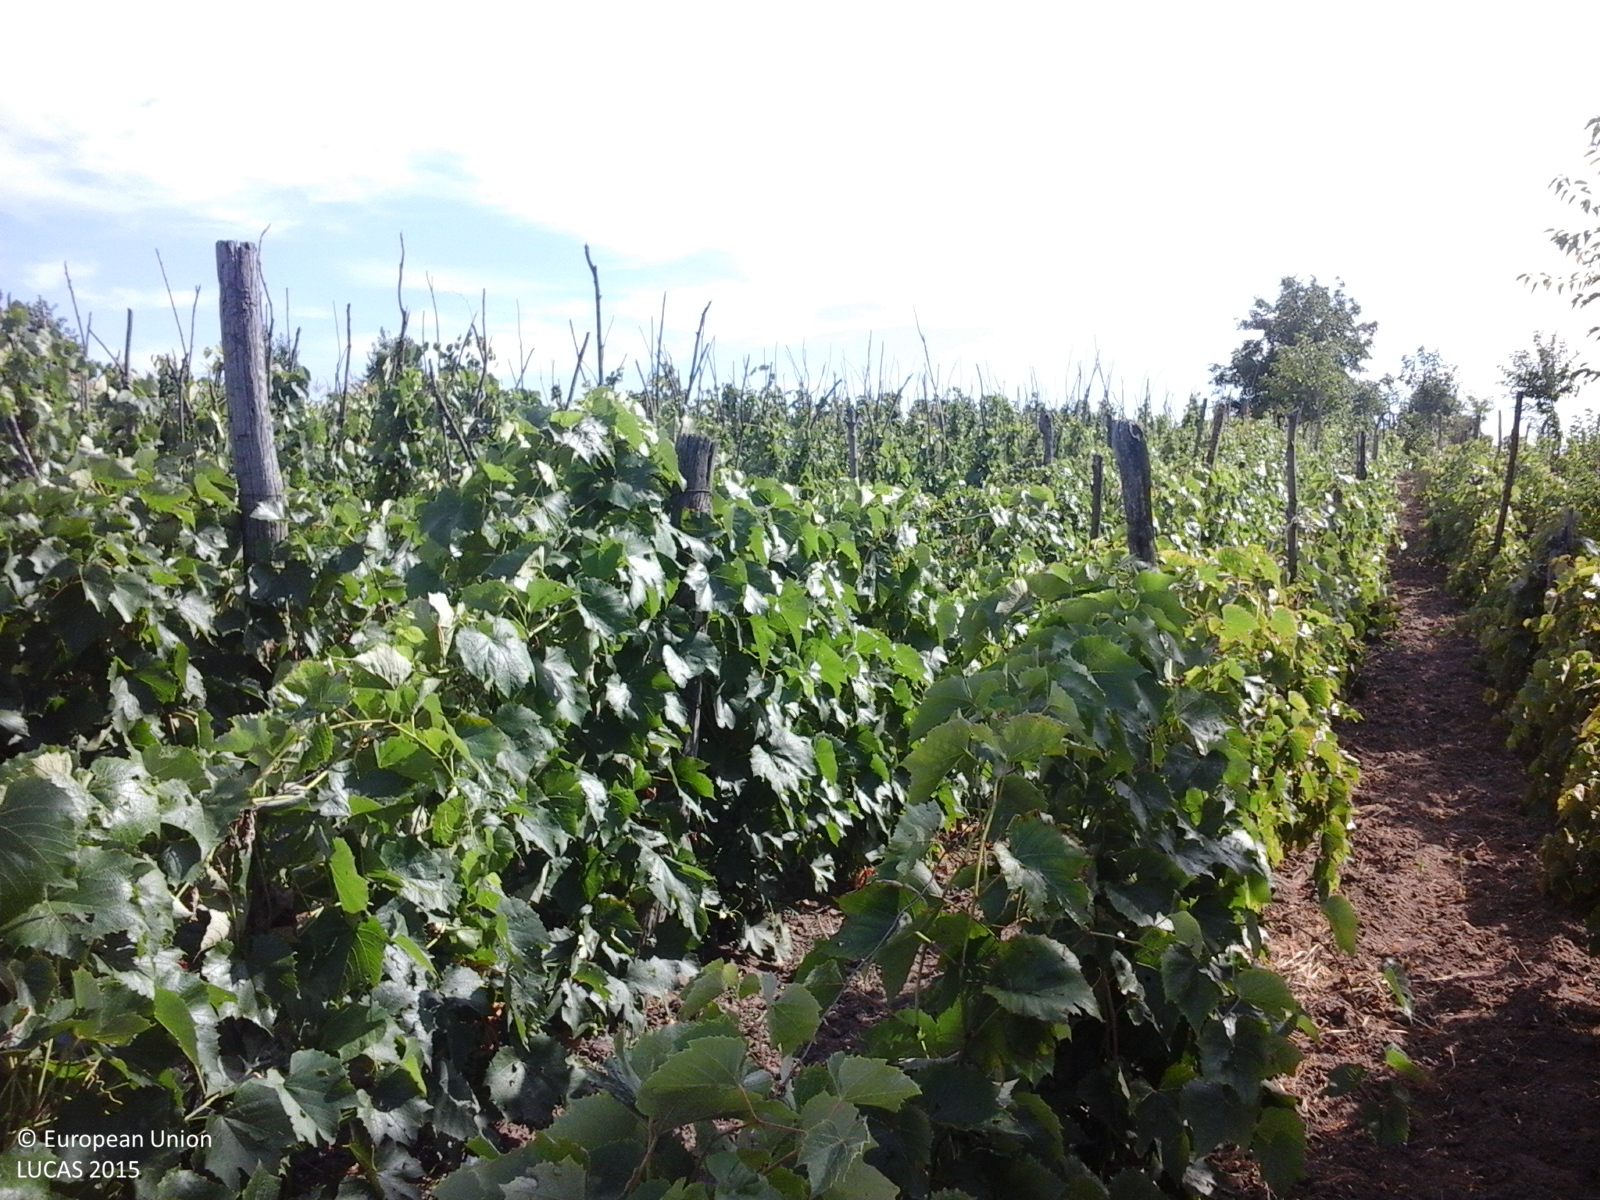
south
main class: Cropland
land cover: Vineyards
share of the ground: > 75 %
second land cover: Grassland without tree/shrub cover
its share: > 75 %
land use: Agriculture (excluding fallow land and kitchen gardens)
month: July
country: RO
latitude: 46.0475
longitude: 27.6488
